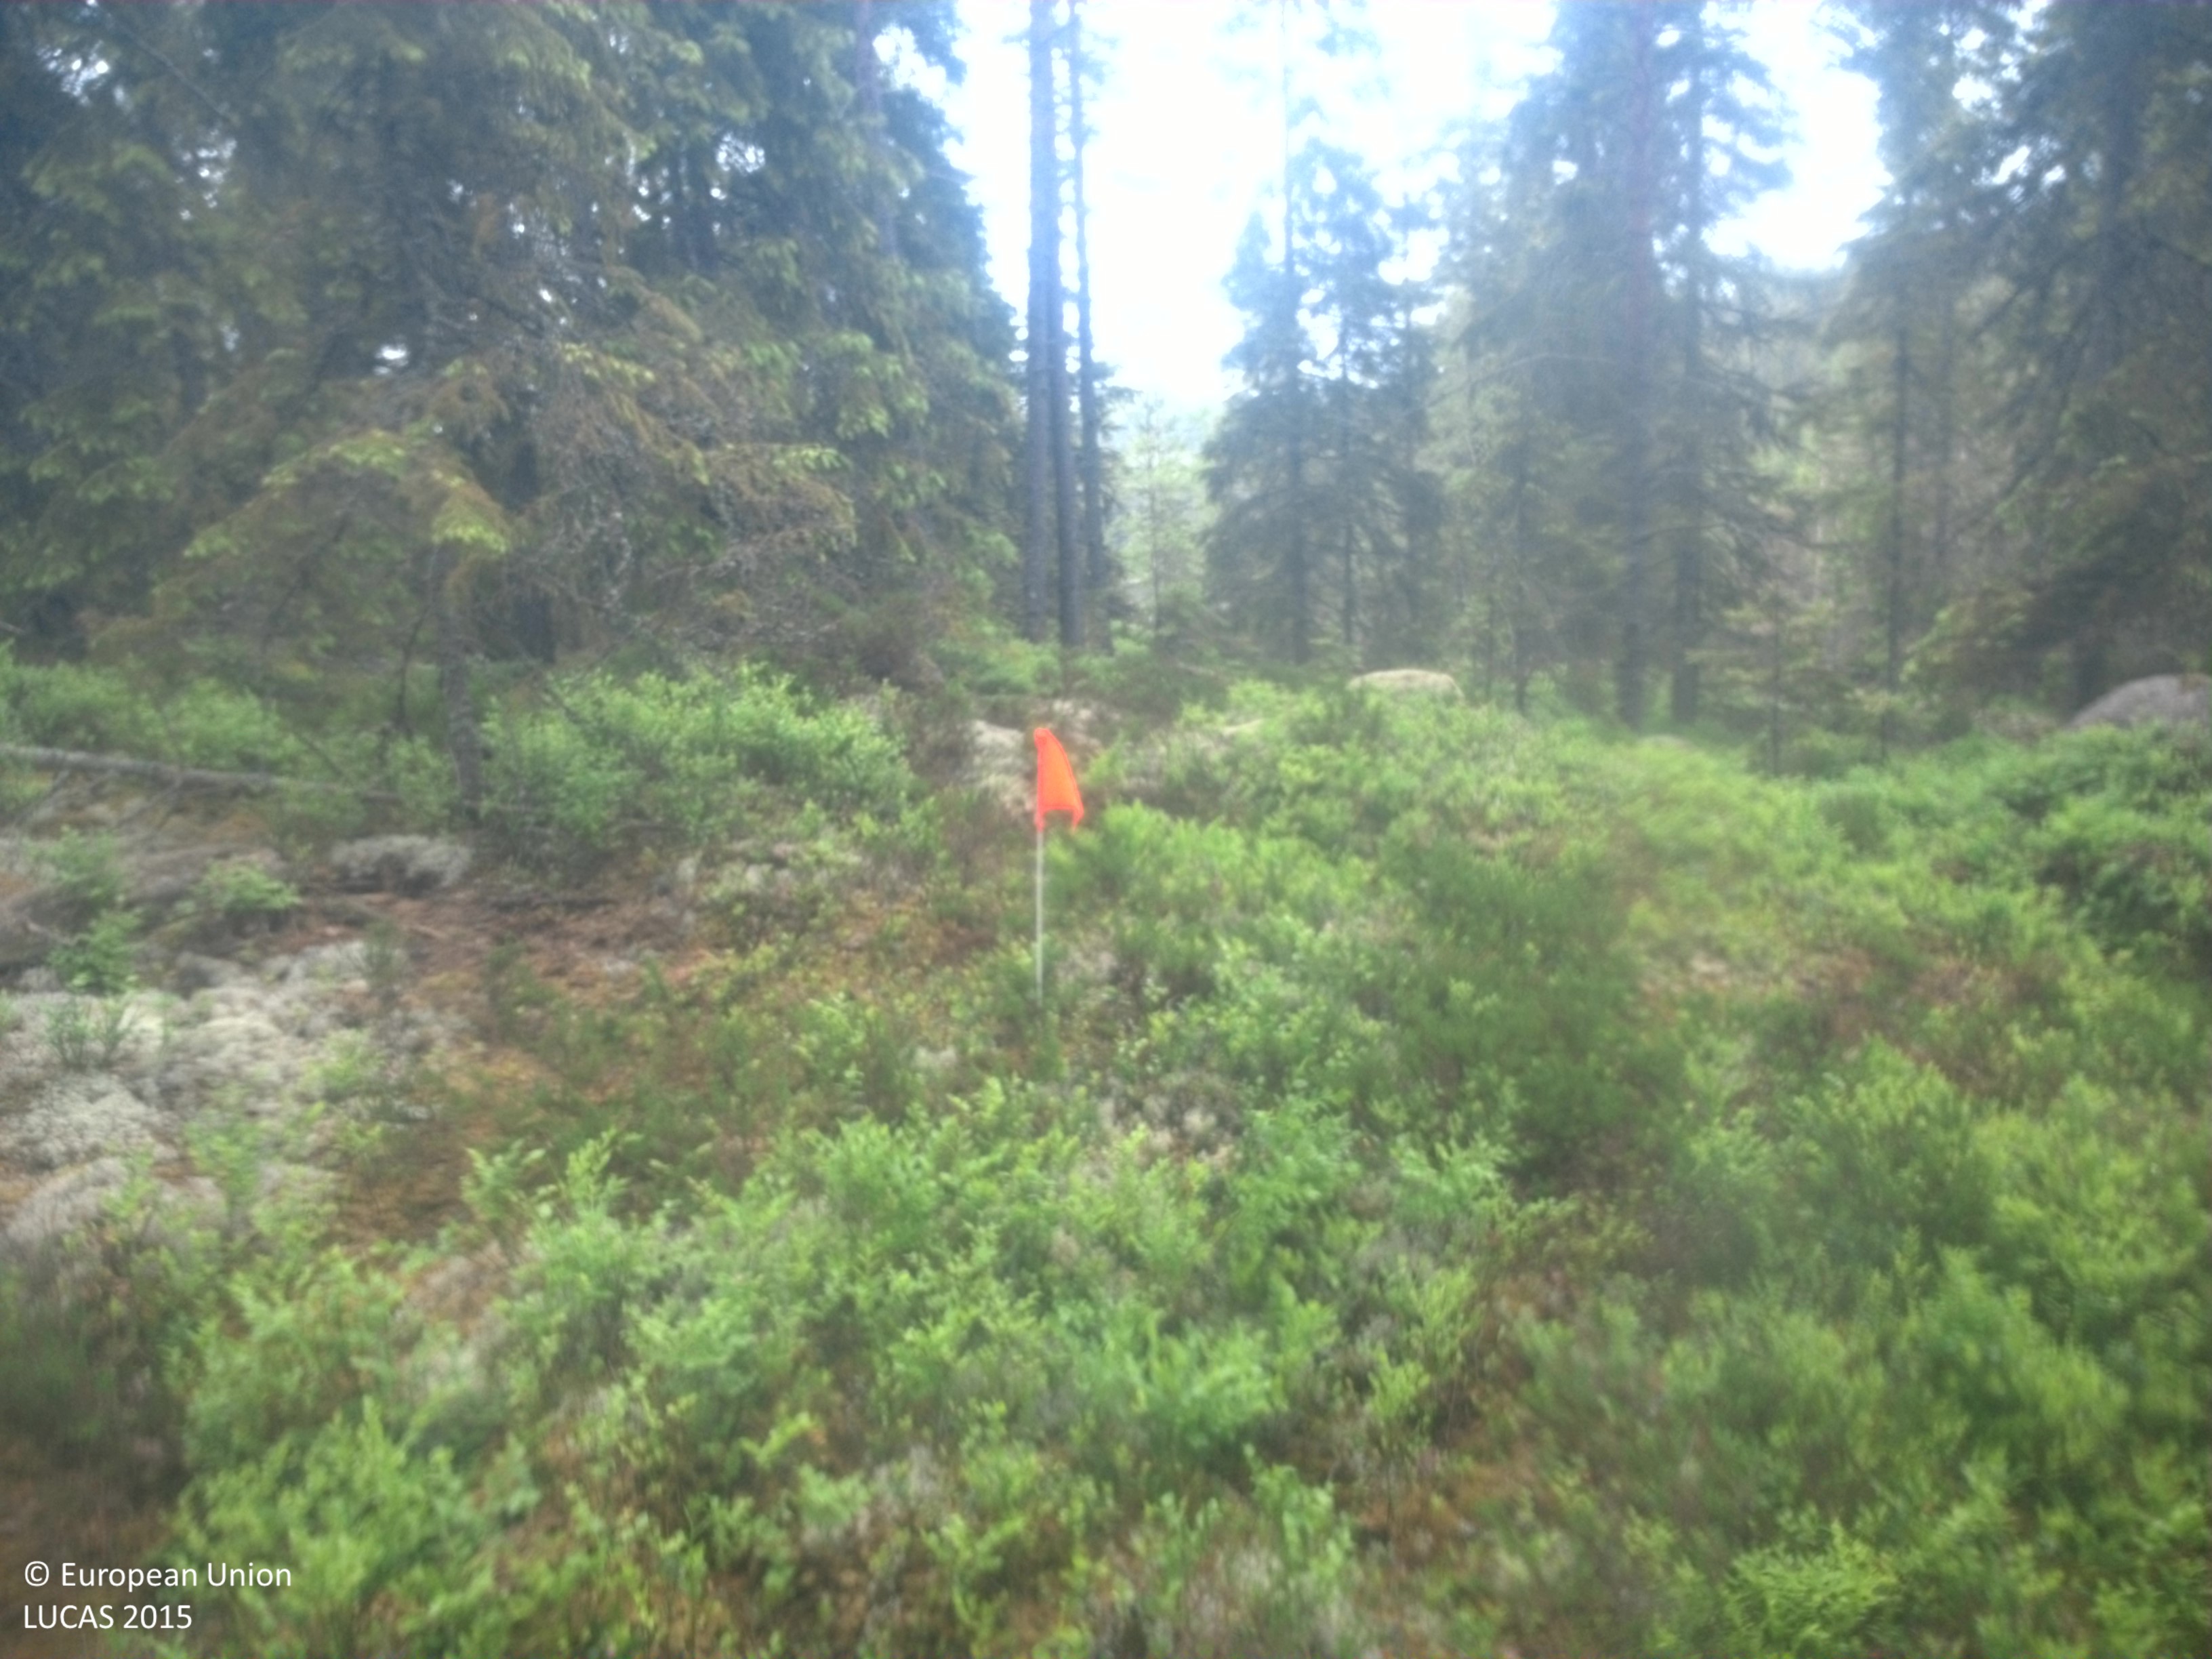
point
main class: Woodland
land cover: Other coniferous woodland
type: boreal forest
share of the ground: 50 - 75 %
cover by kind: coniferous forest trees 60 %, shrubs 20 %, herbaceous plants 10 %, lichens and mosses 5 %, consolidated bare surface 5 %
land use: Forestry
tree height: > 5 m
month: June
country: SE
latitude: 59.4815
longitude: 14.3871
